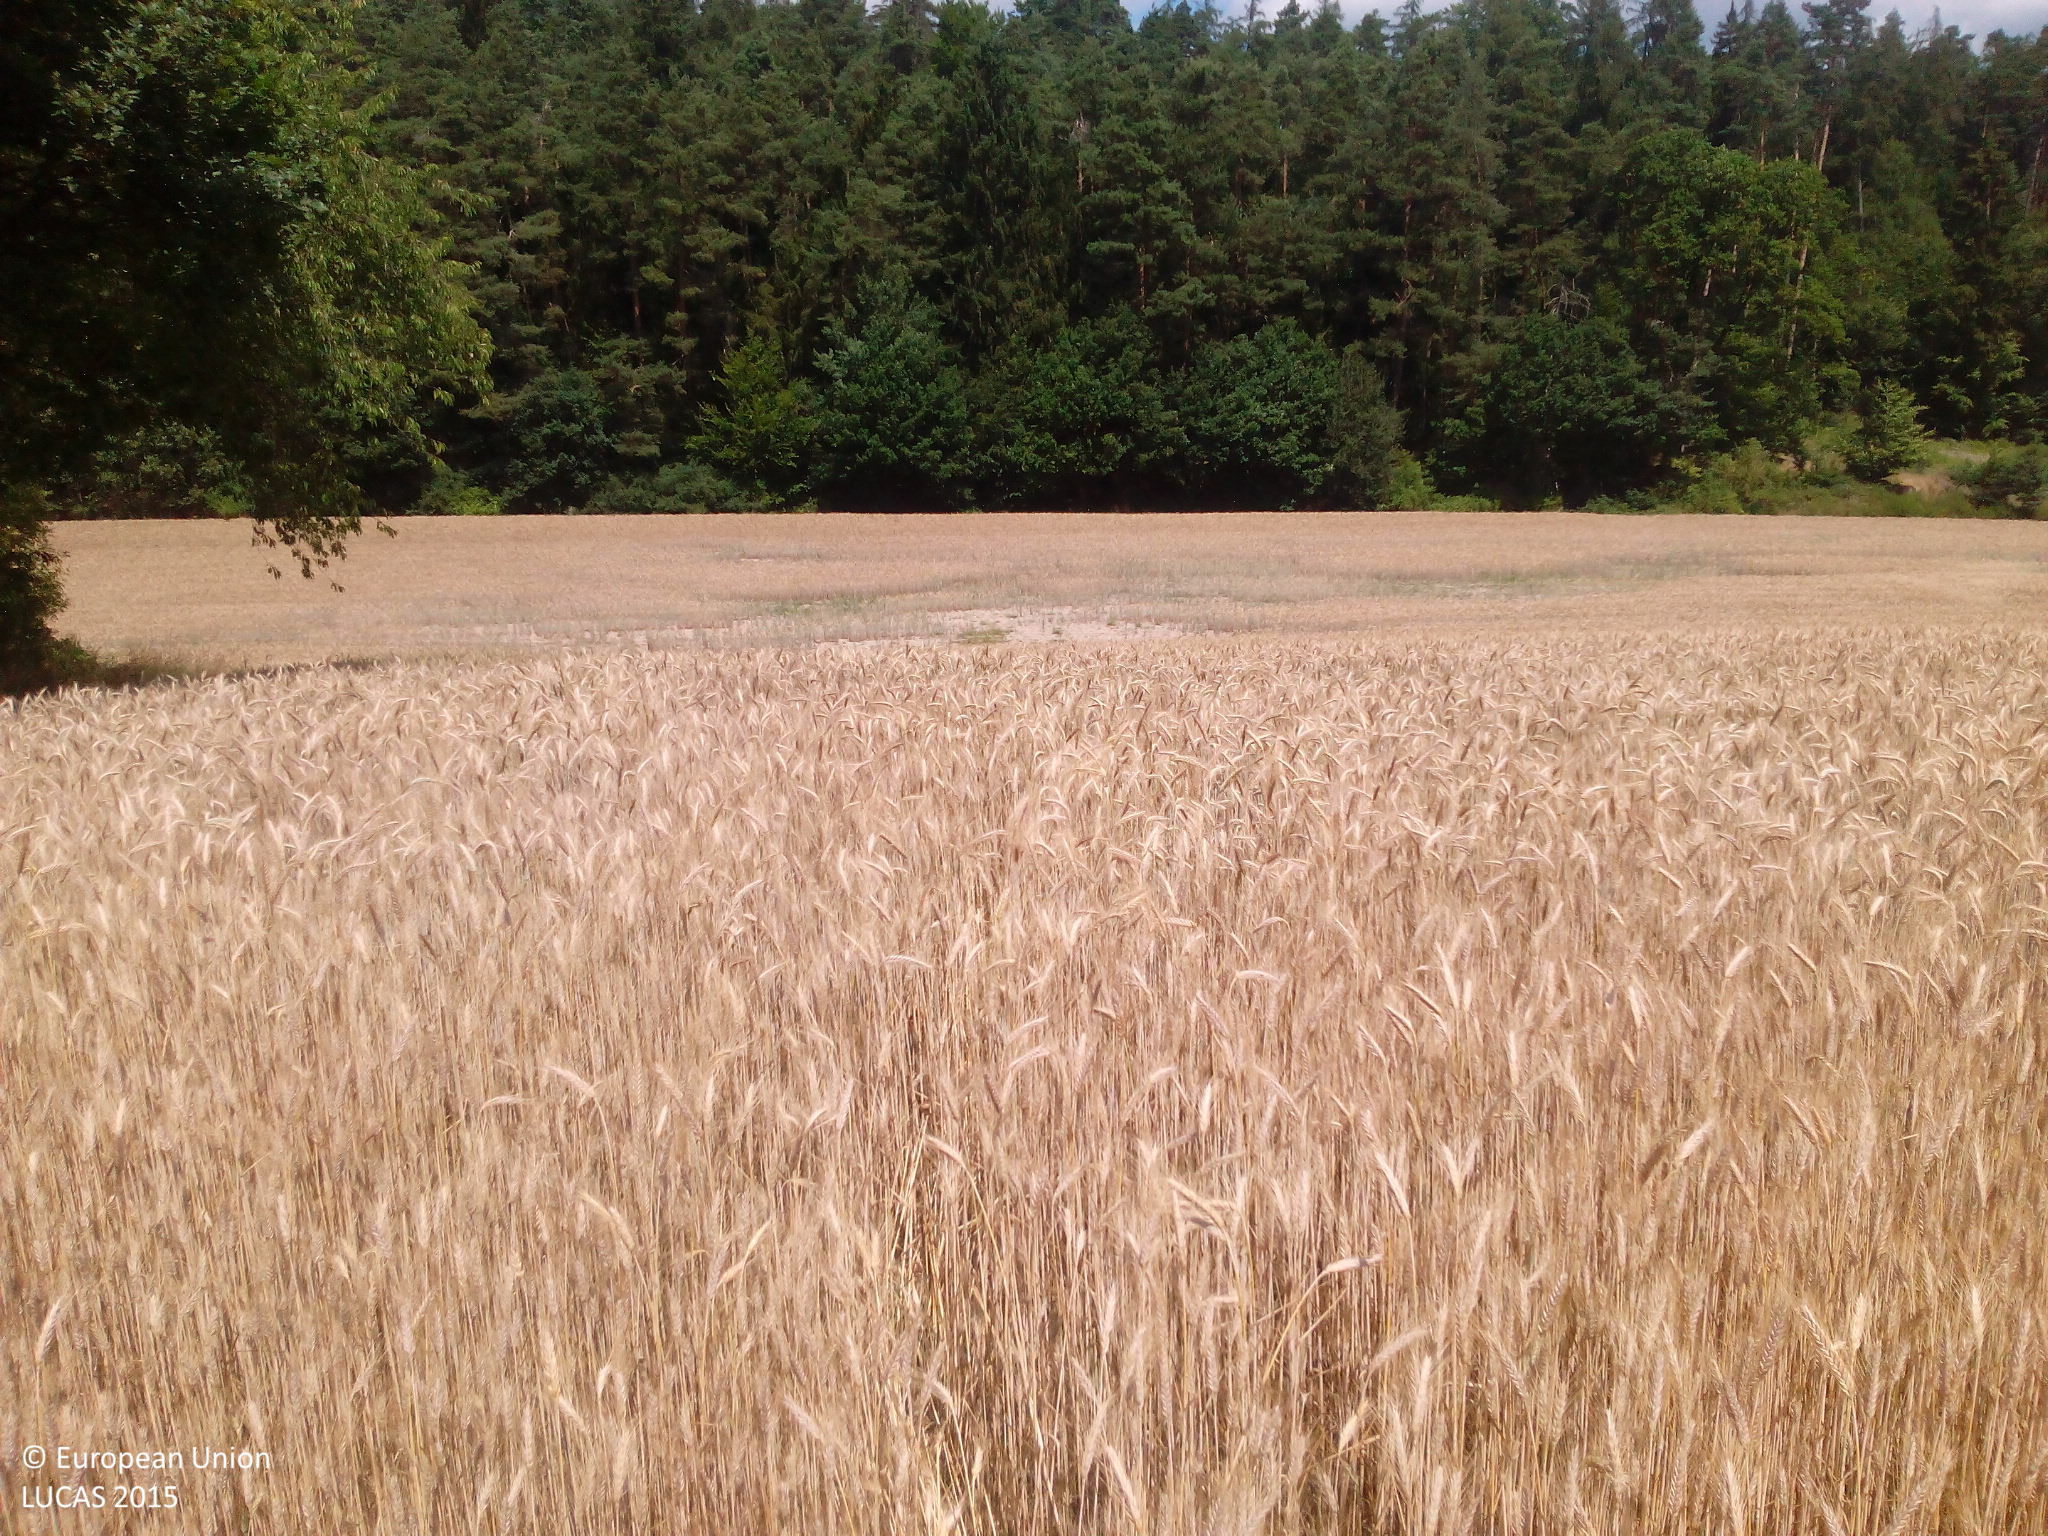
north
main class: Cropland
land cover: Triticale
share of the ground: > 75 %
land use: Agriculture (excluding fallow land and kitchen gardens)
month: July
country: DE
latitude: 49.7872
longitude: 10.5693
